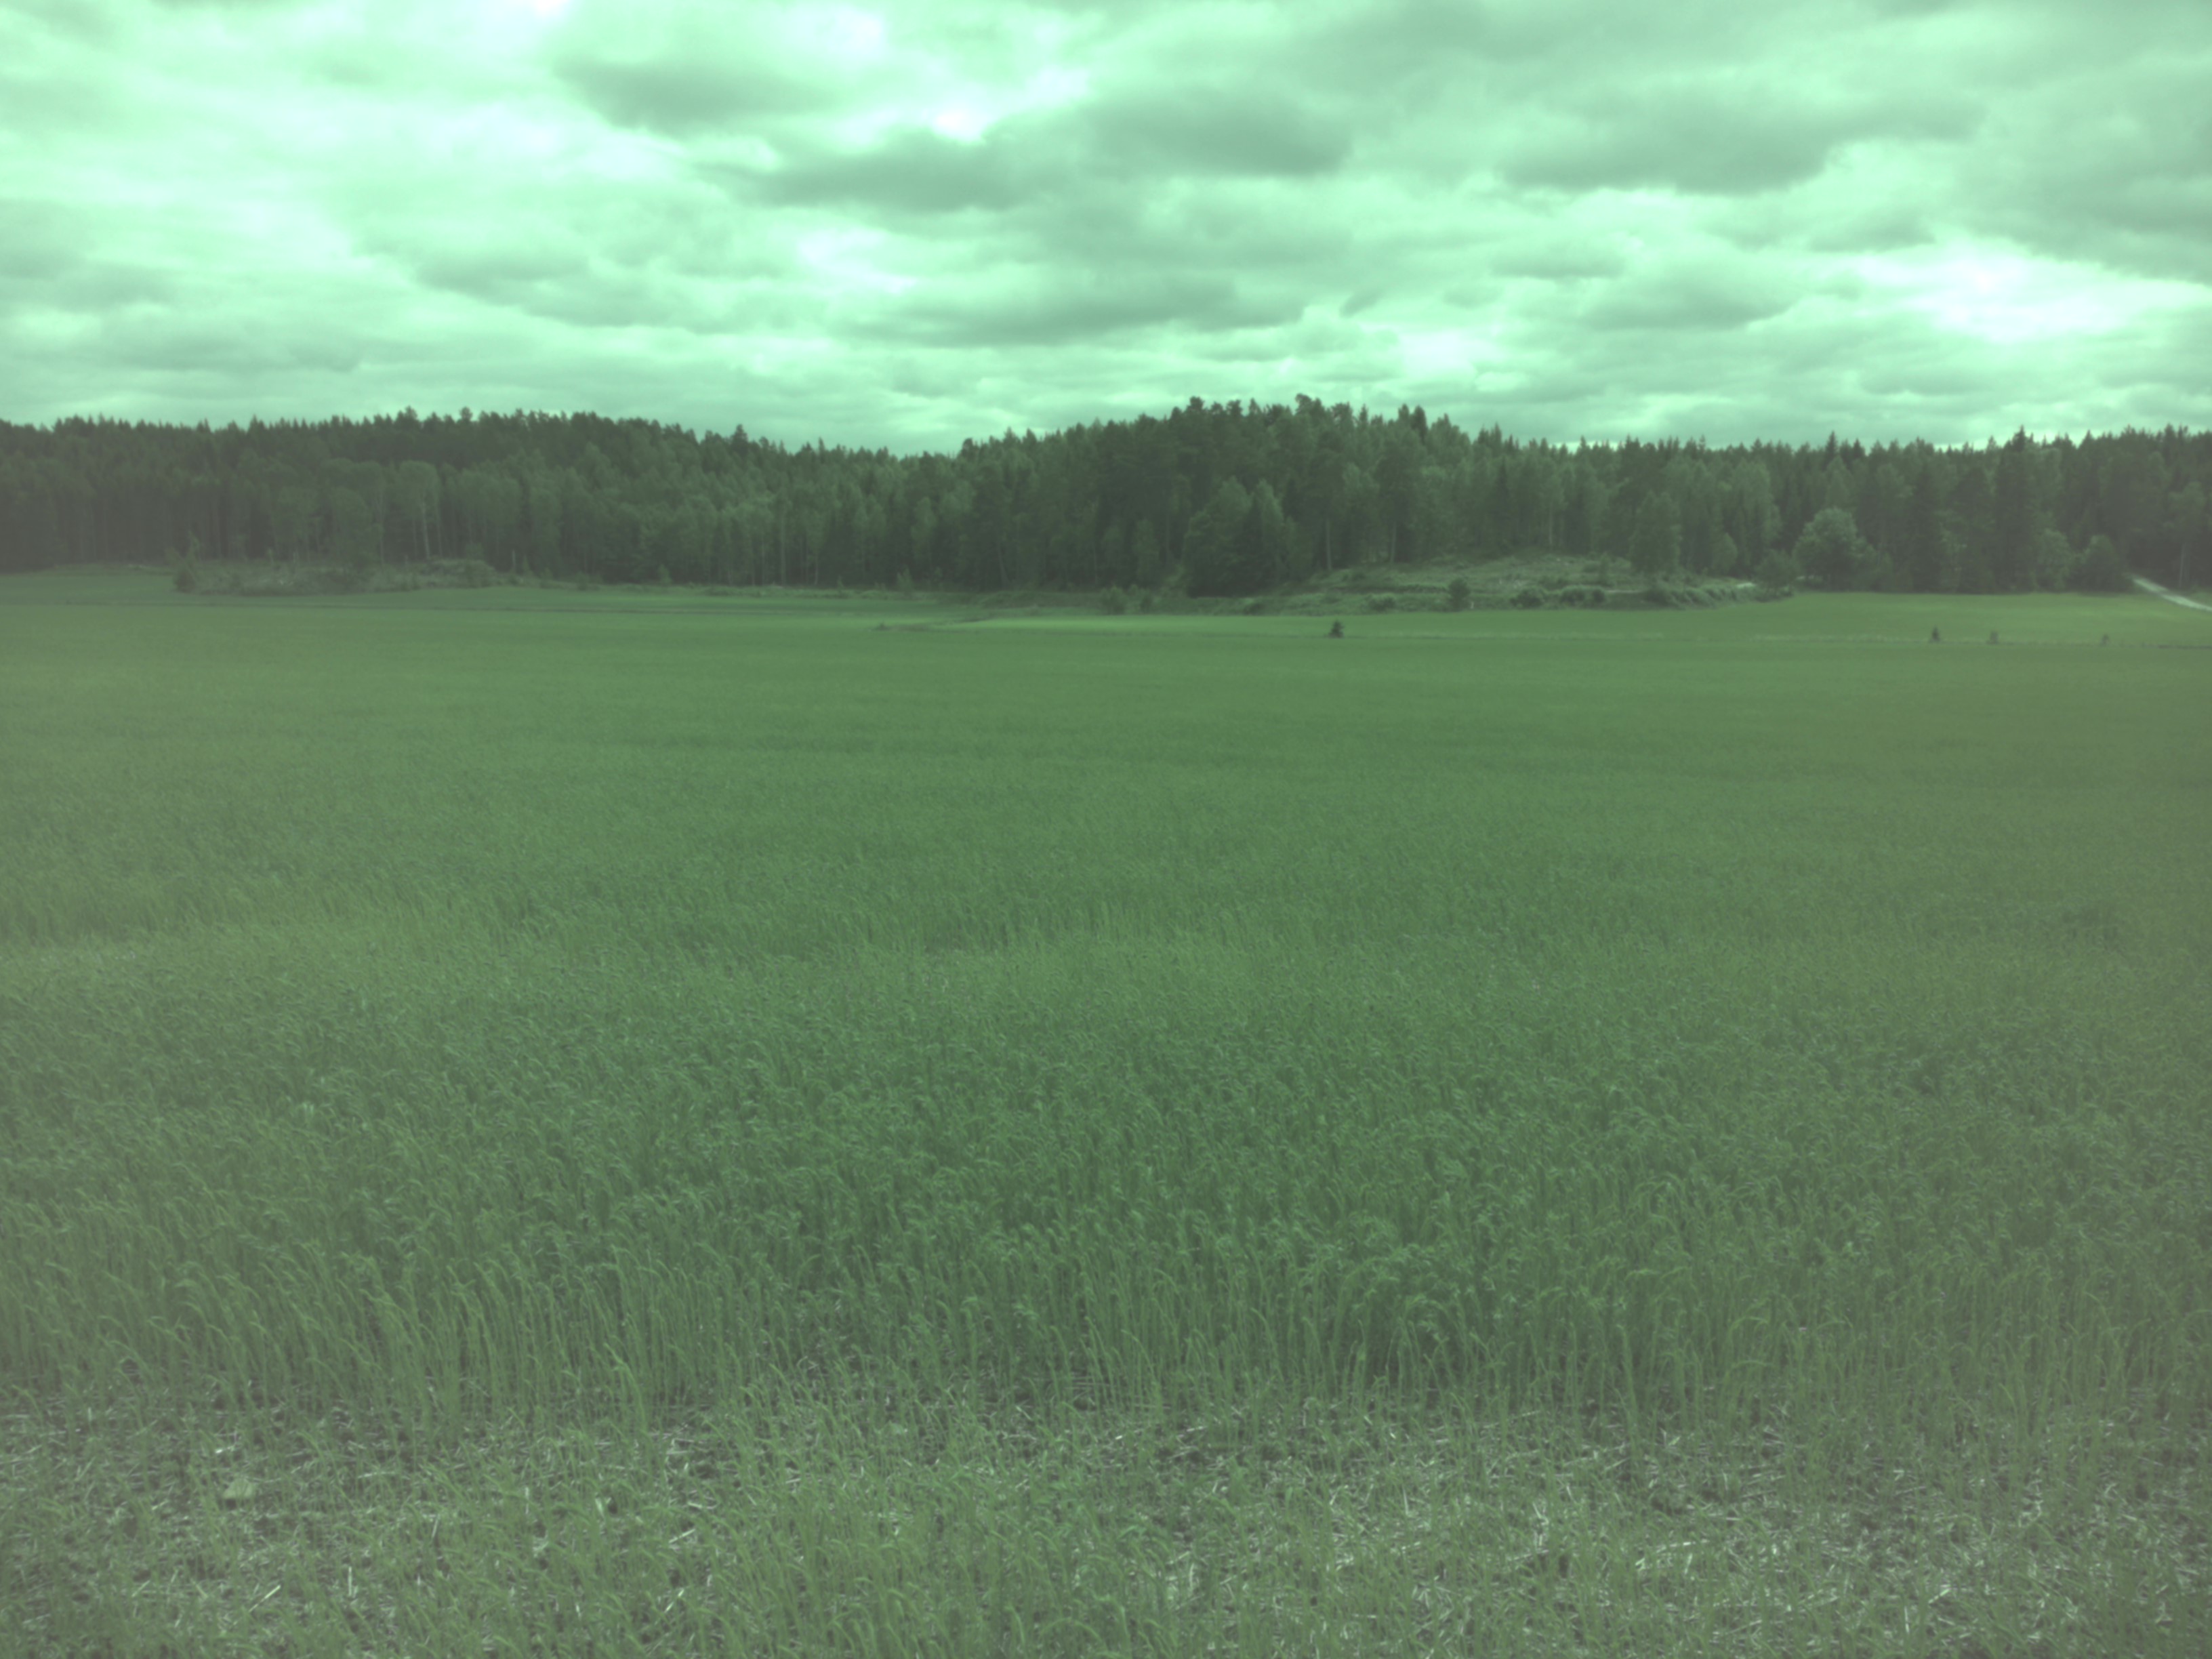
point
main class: Cropland
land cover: Other fibre and oleaginous crops
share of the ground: > 75 %
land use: Agriculture (excluding fallow land and kitchen gardens)
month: June
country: SE
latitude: 59.2780
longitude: 17.4546
